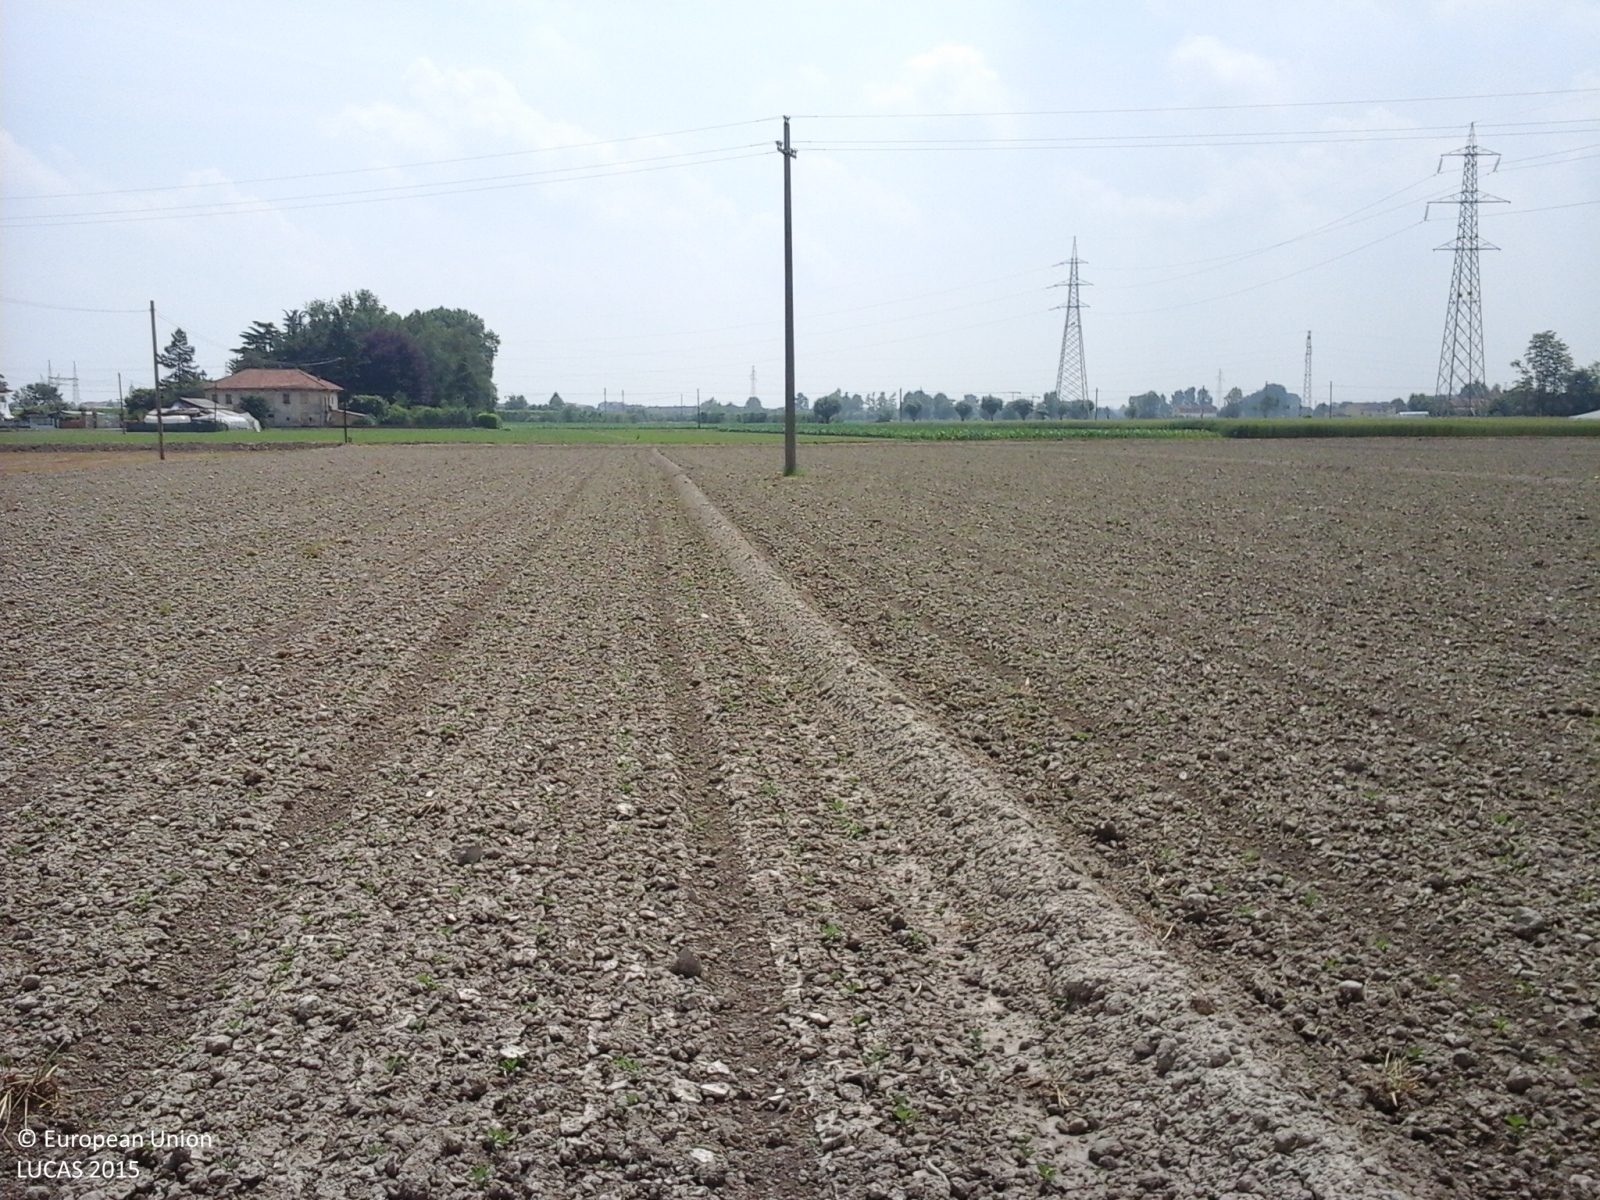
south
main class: Cropland
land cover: Soya
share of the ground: < 10 %
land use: Agriculture (excluding fallow land and kitchen gardens)
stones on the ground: < 10 %
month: June
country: IT
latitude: 44.6666
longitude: 7.6460
